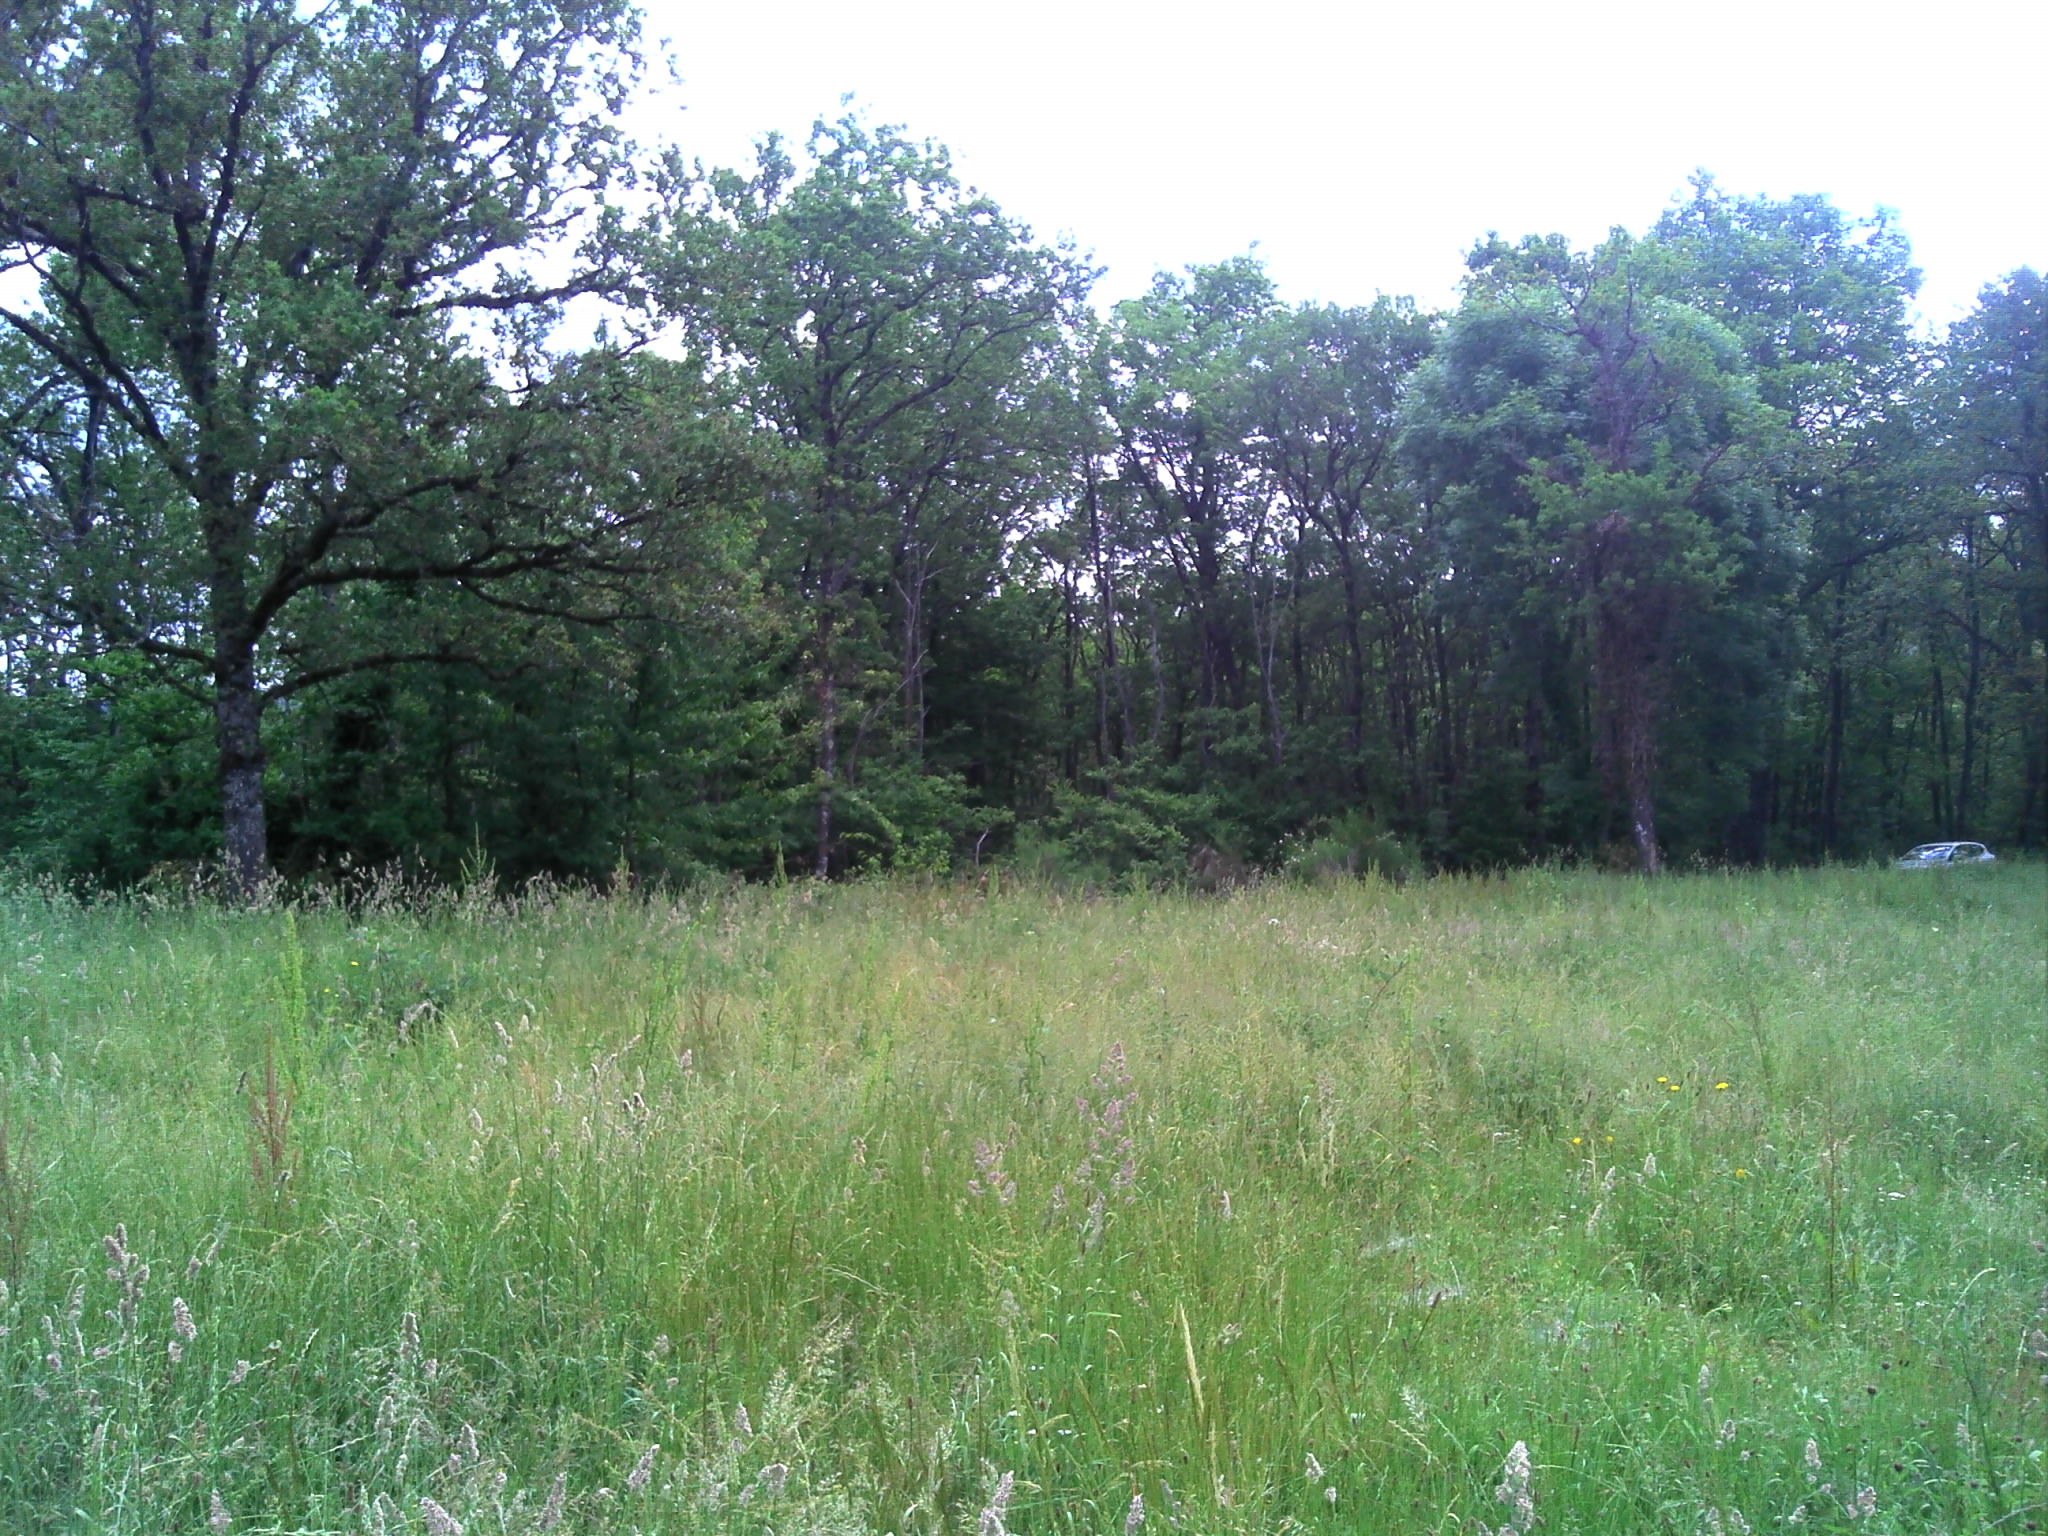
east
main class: Grassland
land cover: Grassland without tree/shrub cover
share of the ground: > 75 %
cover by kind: herbaceous plants 100 %
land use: Agriculture (excluding fallow land and kitchen gardens)
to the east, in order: Grassland without tree/shrub cover; Fences; Grass margins; Paved roads, cycling and walking lanes; Grass margins; Broadleaved woodland
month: June
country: FR
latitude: 44.6925
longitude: 1.9868
